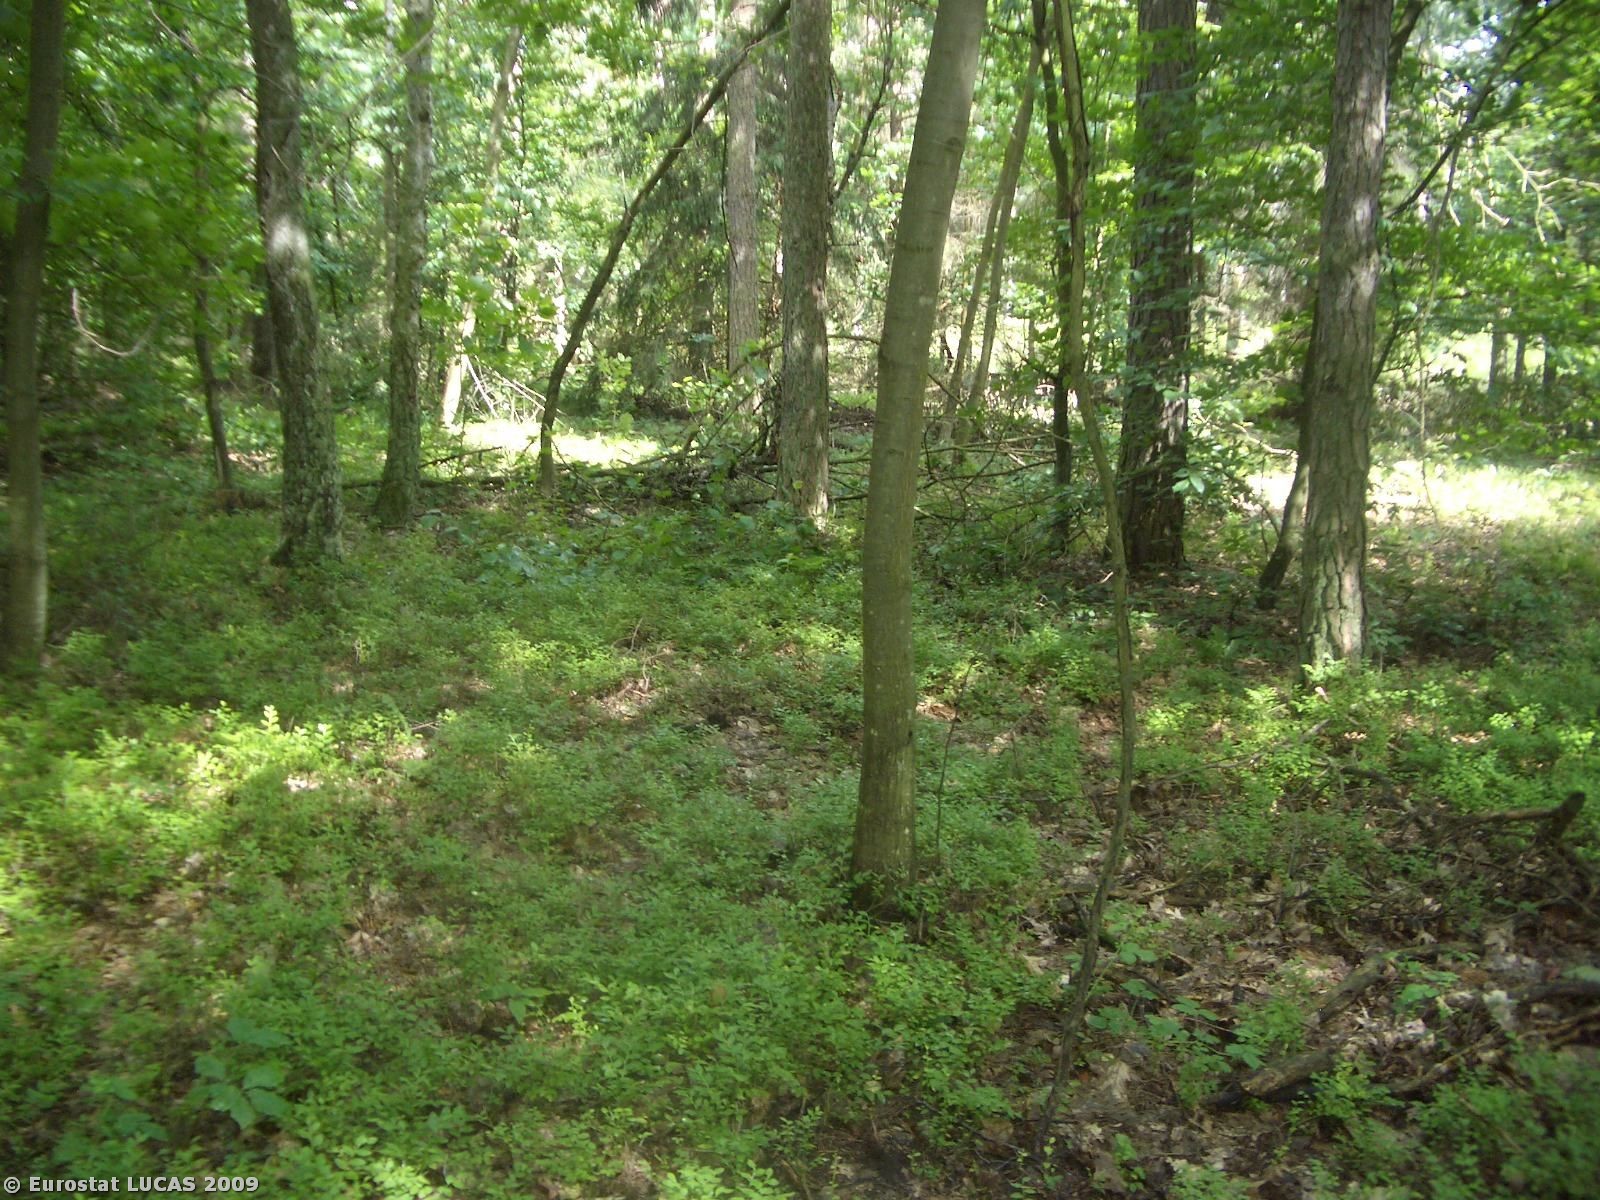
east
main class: Woodland
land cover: Mixed woodland
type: hemiboreal forest and nemoral coniferous forest and mixed broadleaved-coniferous forest
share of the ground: 50 - 75 %
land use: Forestry
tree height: > 5 m
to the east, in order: Mixed woodland
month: July
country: PL
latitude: 51.7843
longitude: 22.5189
